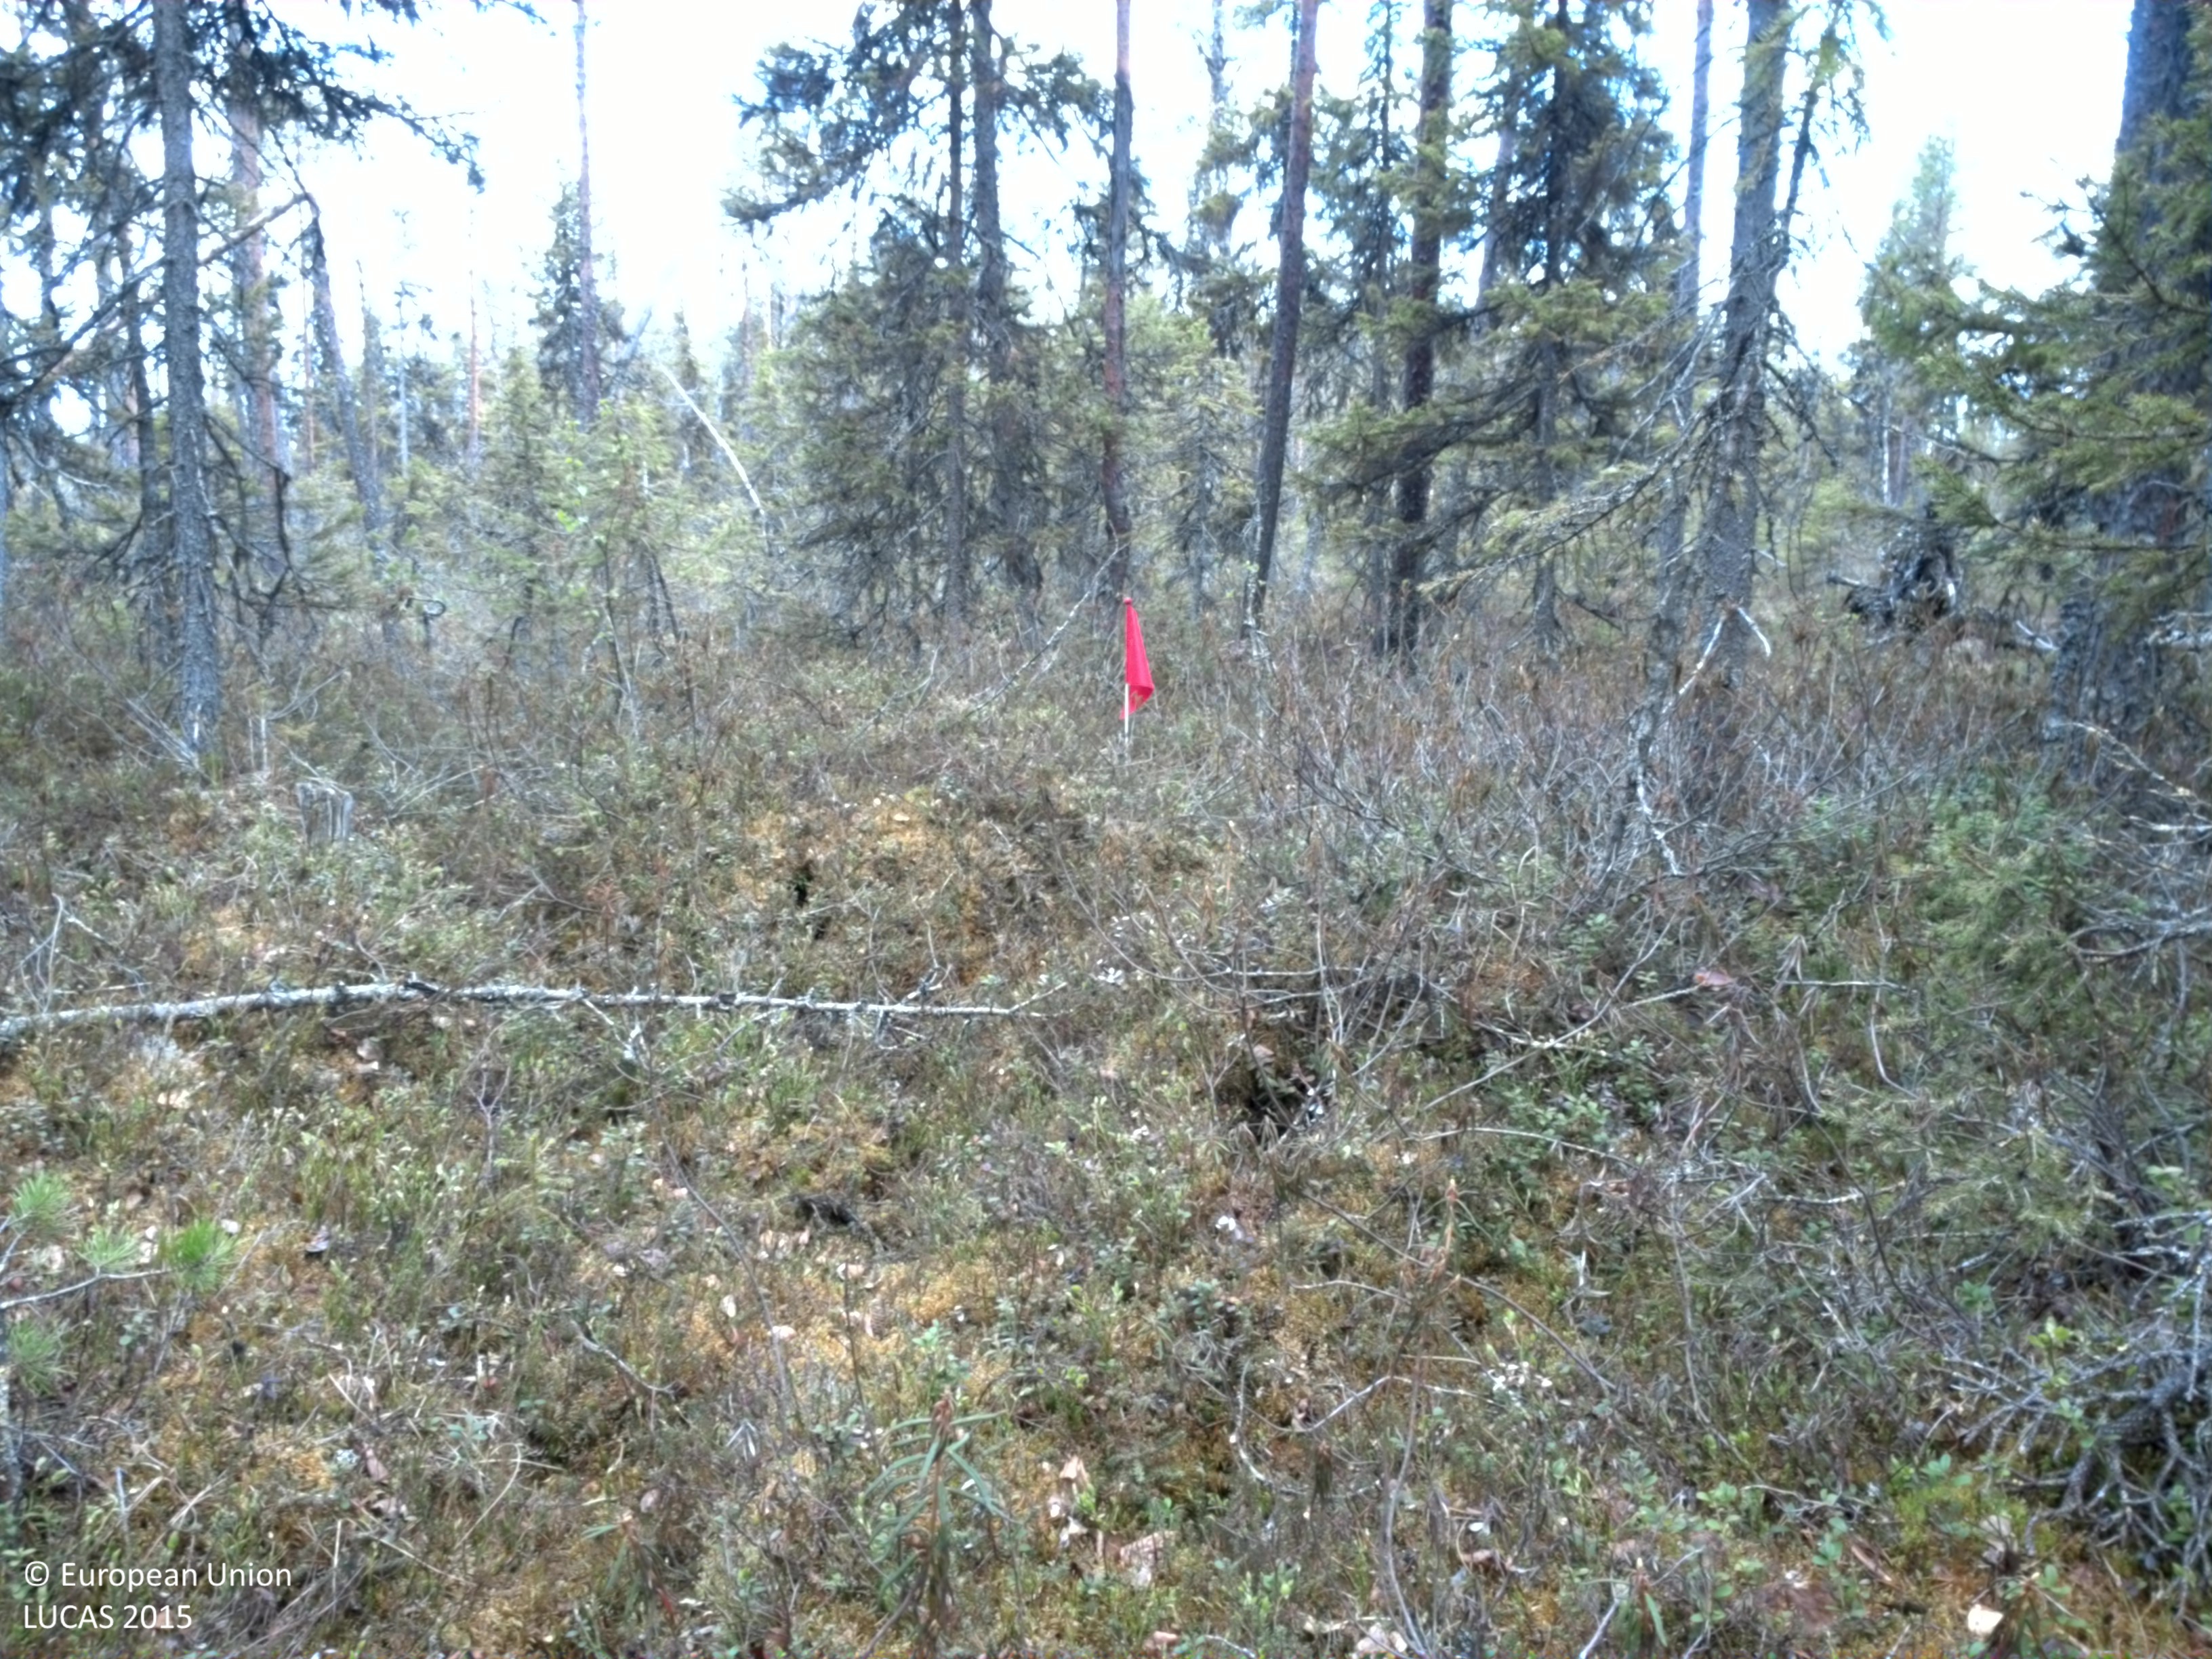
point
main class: Woodland
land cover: Other coniferous woodland
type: mire and swamp forests
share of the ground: 50 - 75 %
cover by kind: coniferous forest trees 55 %, shrubs 40 %, lichens and mosses 5 %
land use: Forestry
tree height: > 5 m
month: June
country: SE
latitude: 66.4968
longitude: 22.8971
